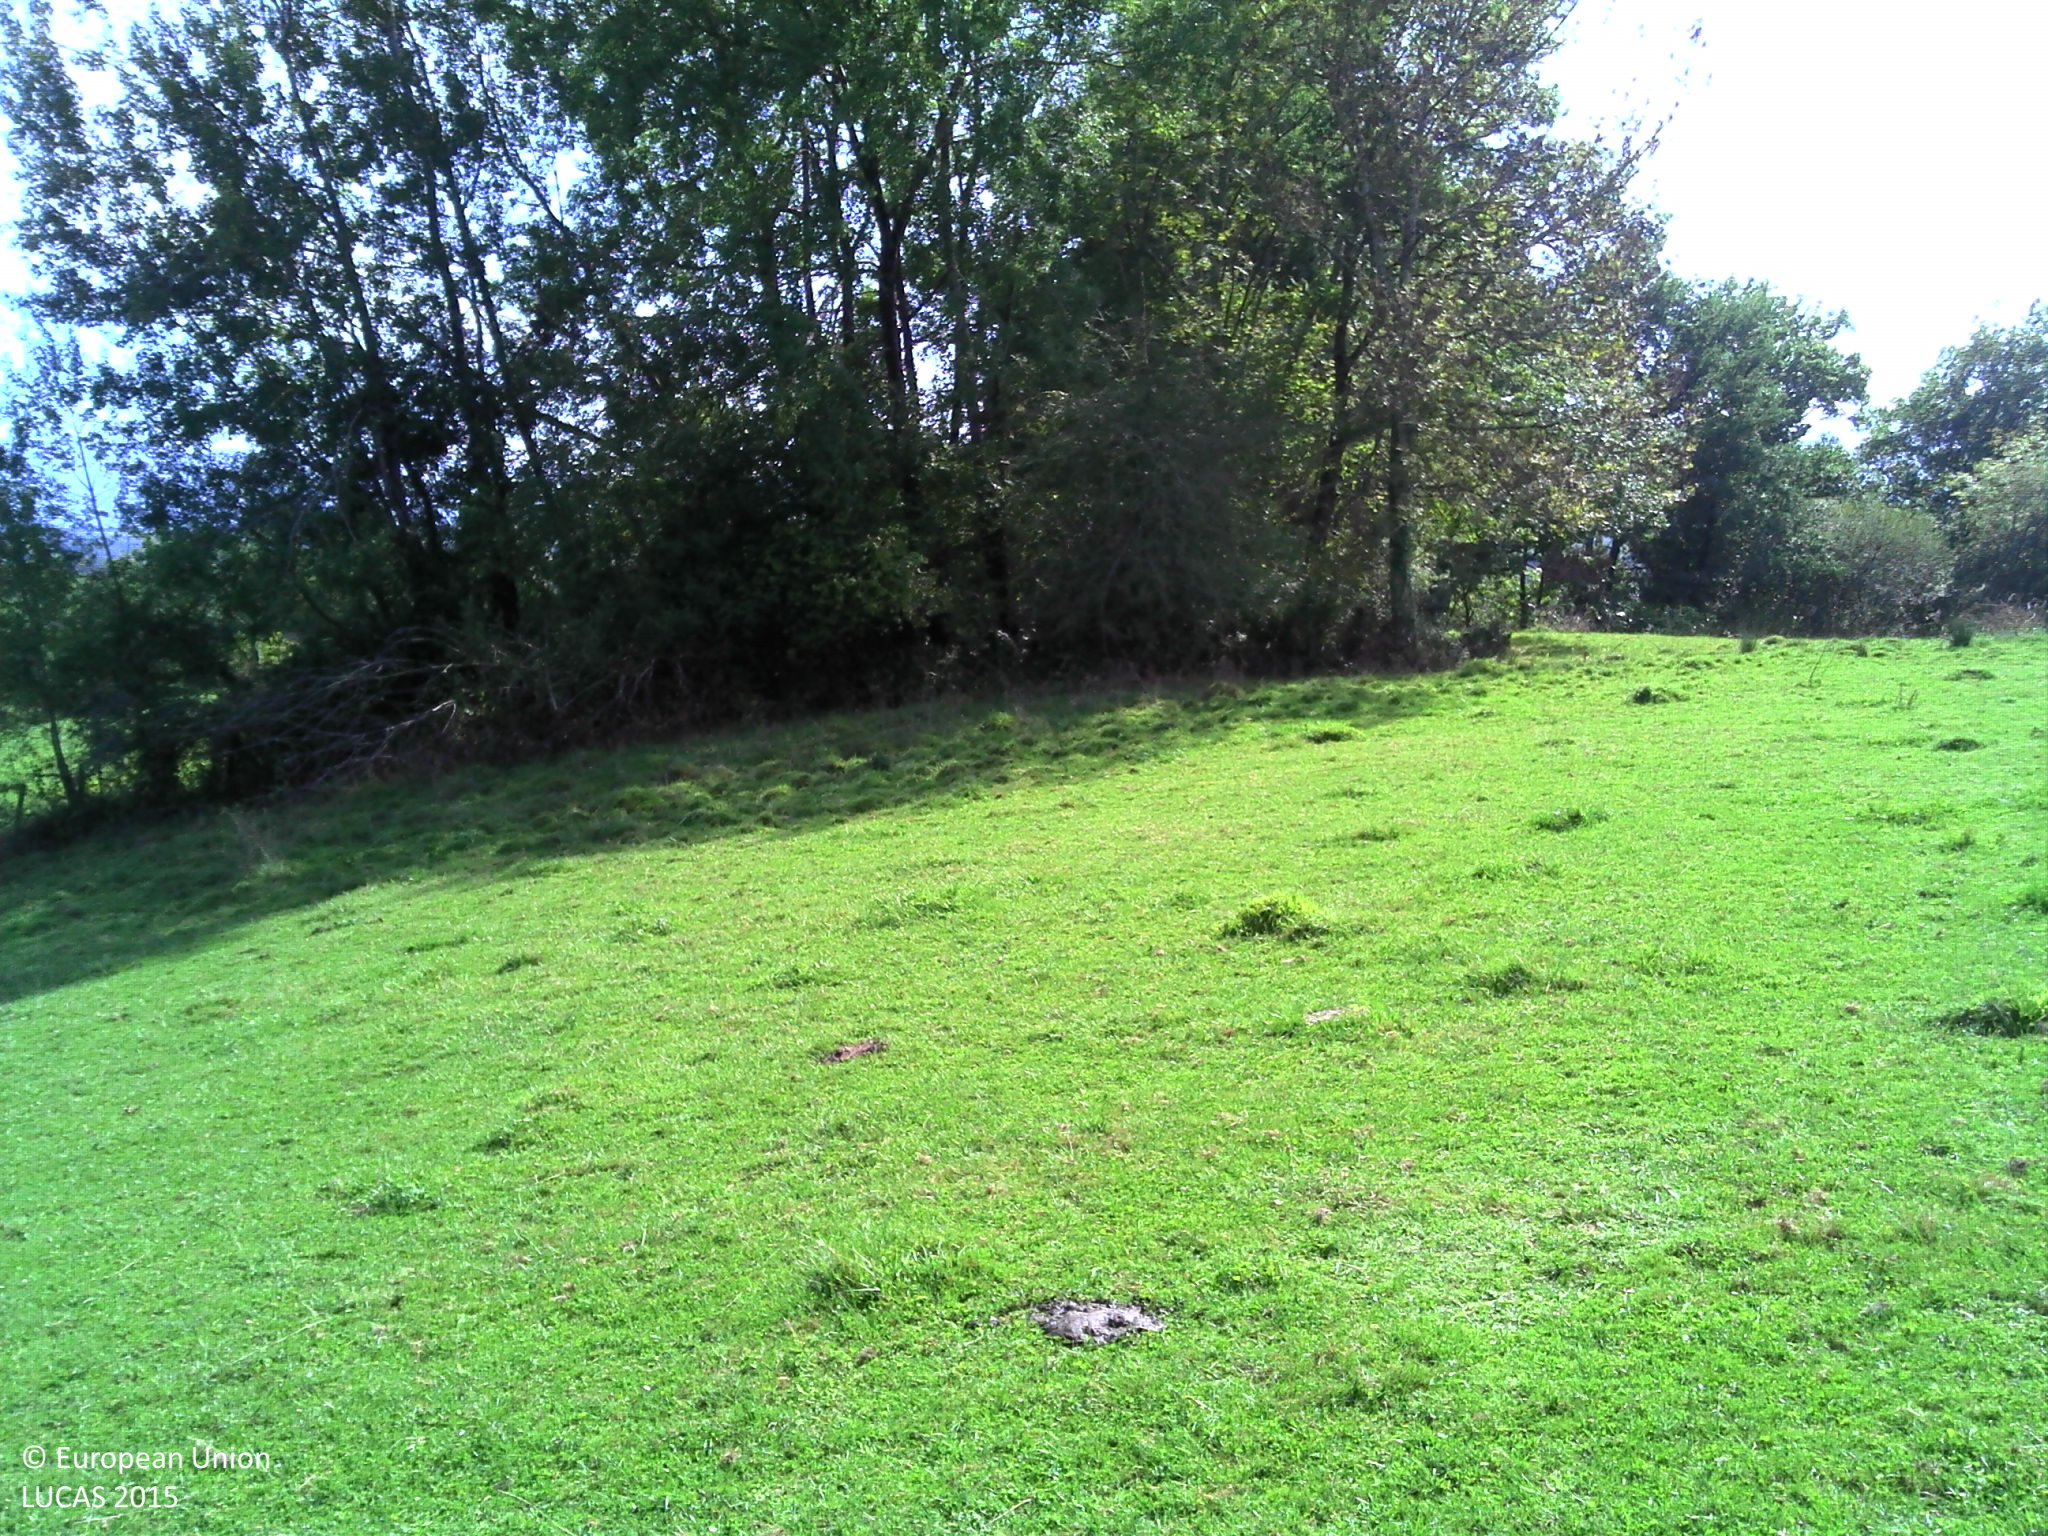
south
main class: Grassland
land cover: Grassland without tree/shrub cover
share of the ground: > 75 %
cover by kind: herbaceous plants 100 %
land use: Agriculture (excluding fallow land and kitchen gardens)
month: September
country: FR
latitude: 43.2207
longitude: -0.4589
